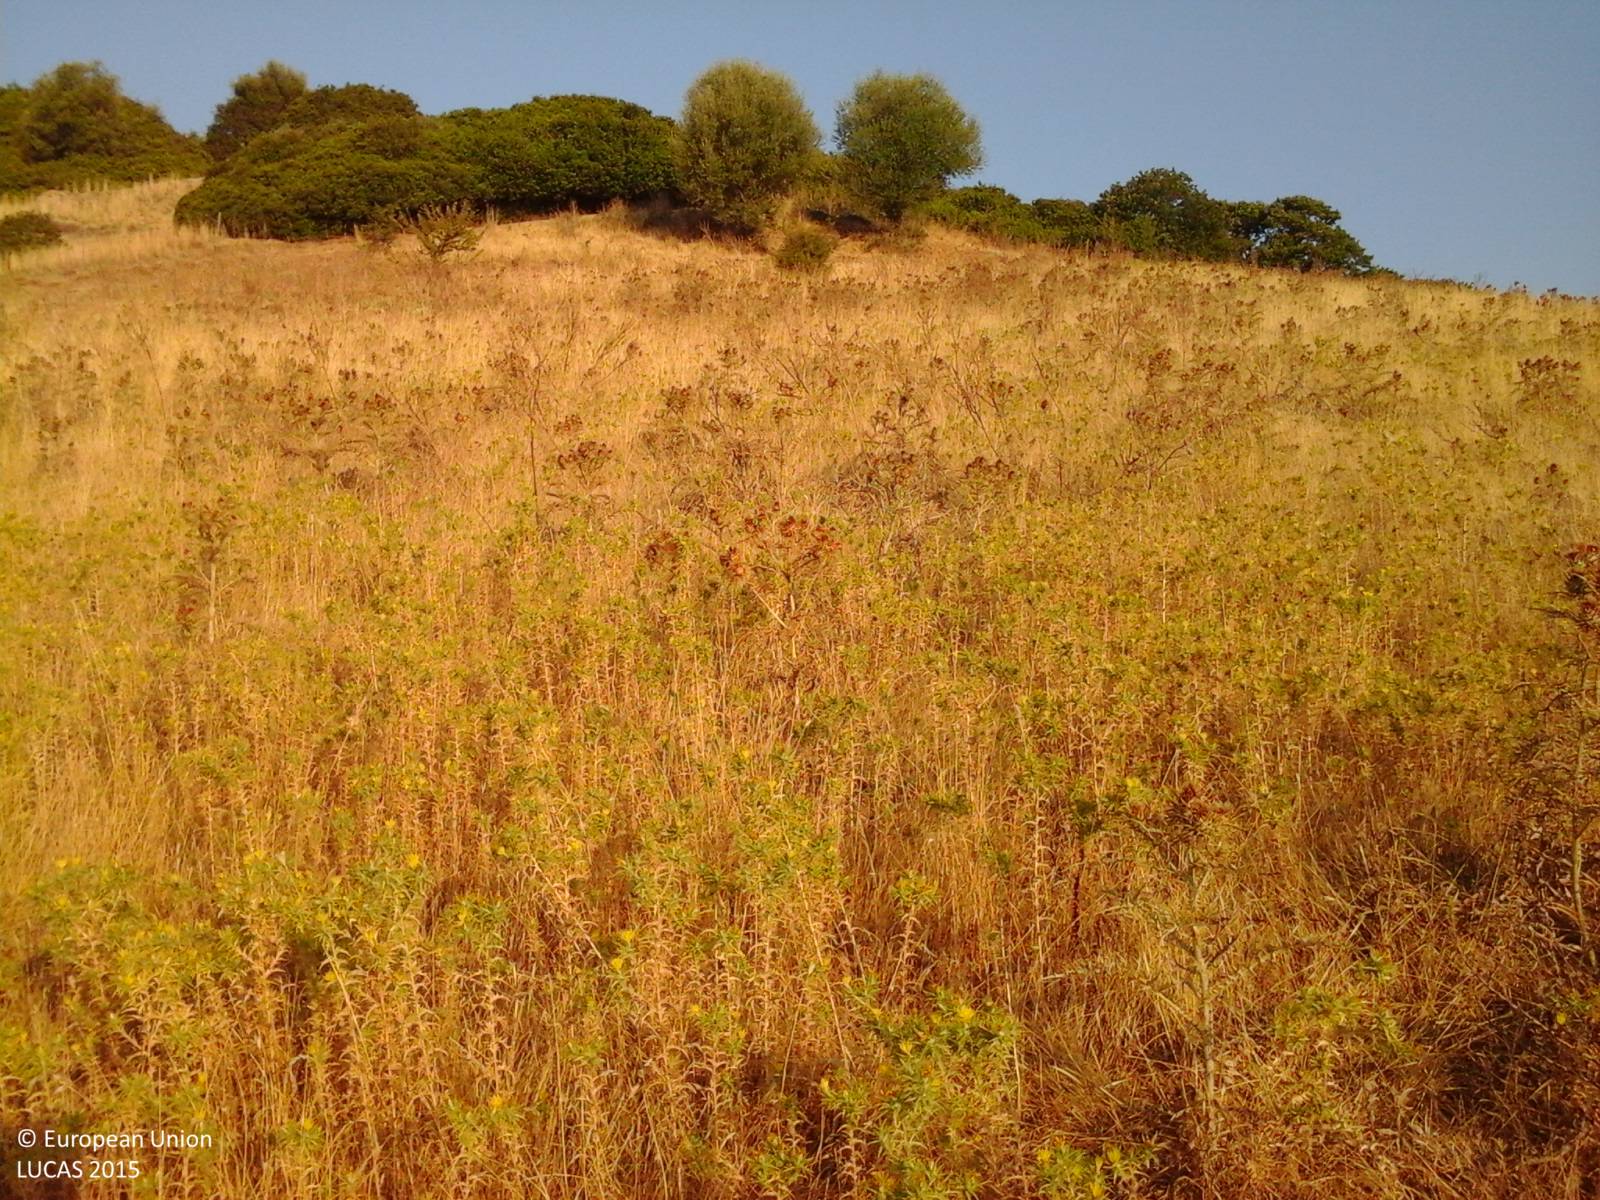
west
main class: Grassland
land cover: Spontaneously vegetated surfaces
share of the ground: > 75 %
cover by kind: herbaceous plants 100 %
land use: Agriculture (excluding fallow land and kitchen gardens)
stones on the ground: < 10 %
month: July
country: IT
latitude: 40.7855
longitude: 8.8560
